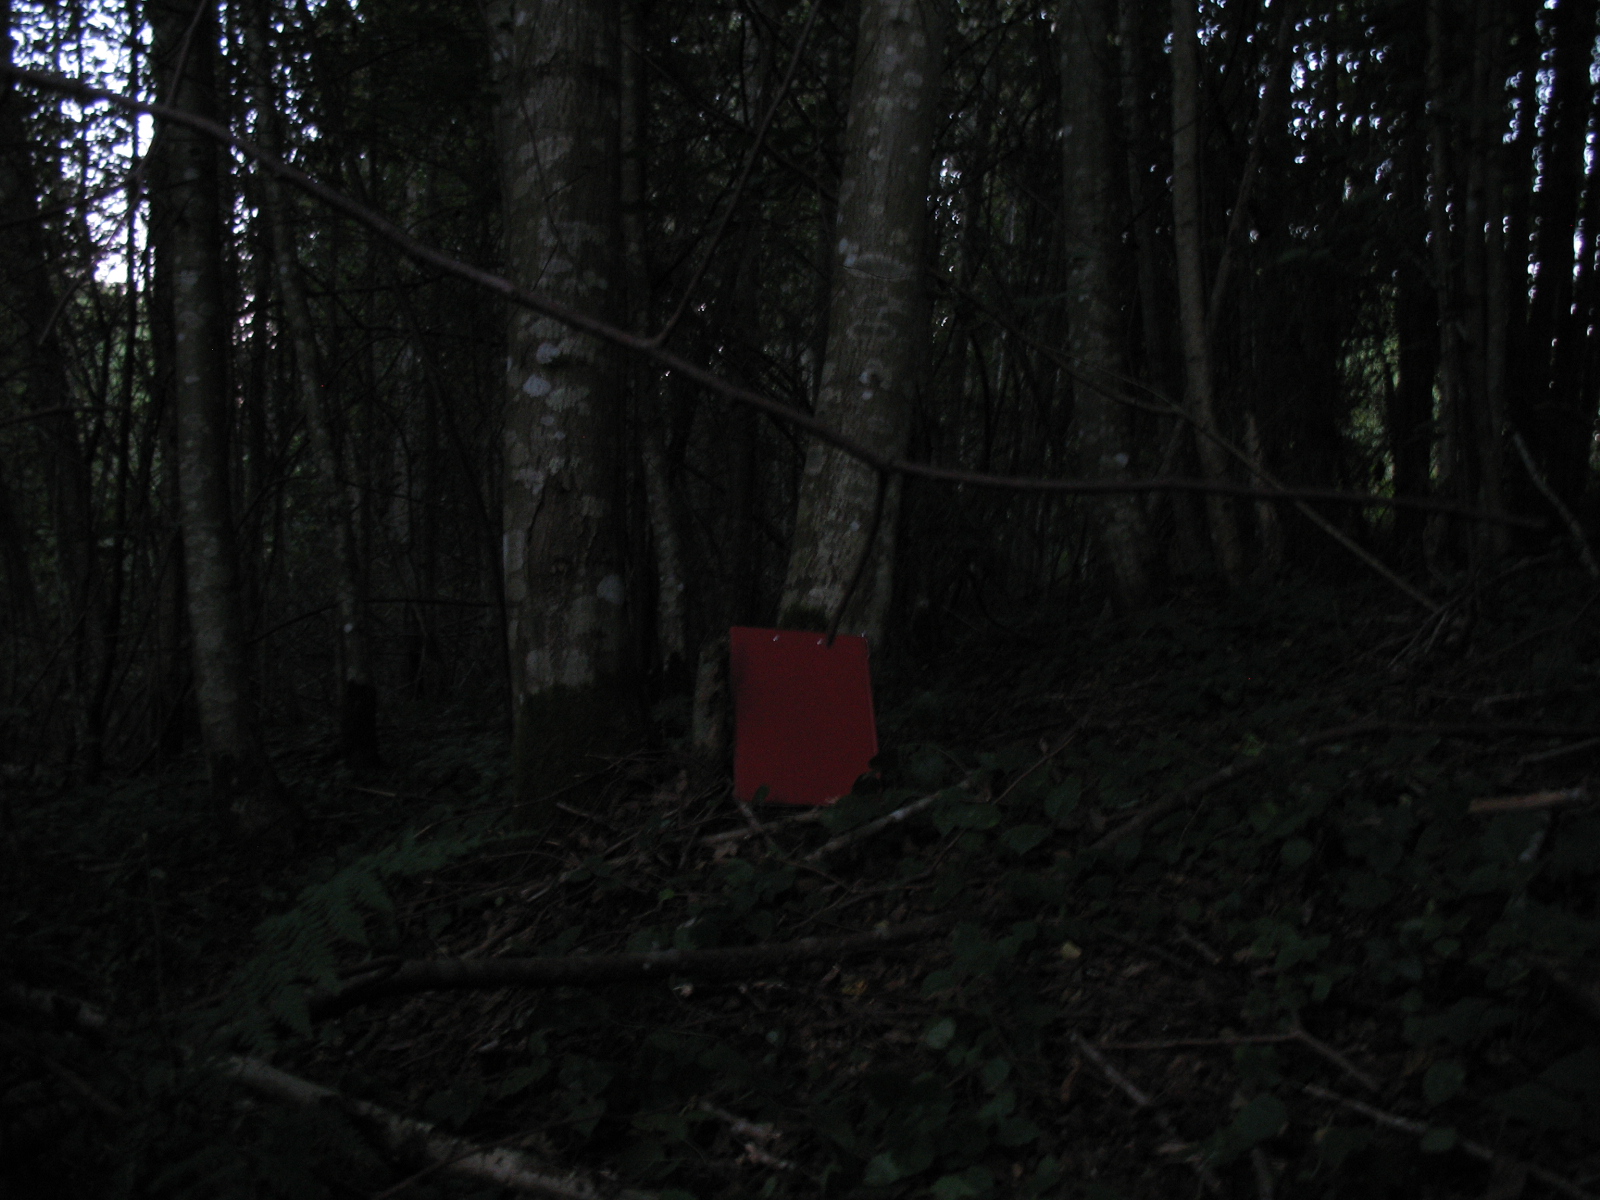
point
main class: Woodland
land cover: Broadleaved woodland
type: non-riverine alder, birch or aspen forest
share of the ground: > 75 %
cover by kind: broadleaved forest trees 90 %, unconsolidated bare surface 5 %
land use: Forestry
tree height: > 5 m
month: August
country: LV
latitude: 56.4702
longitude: 25.6257
